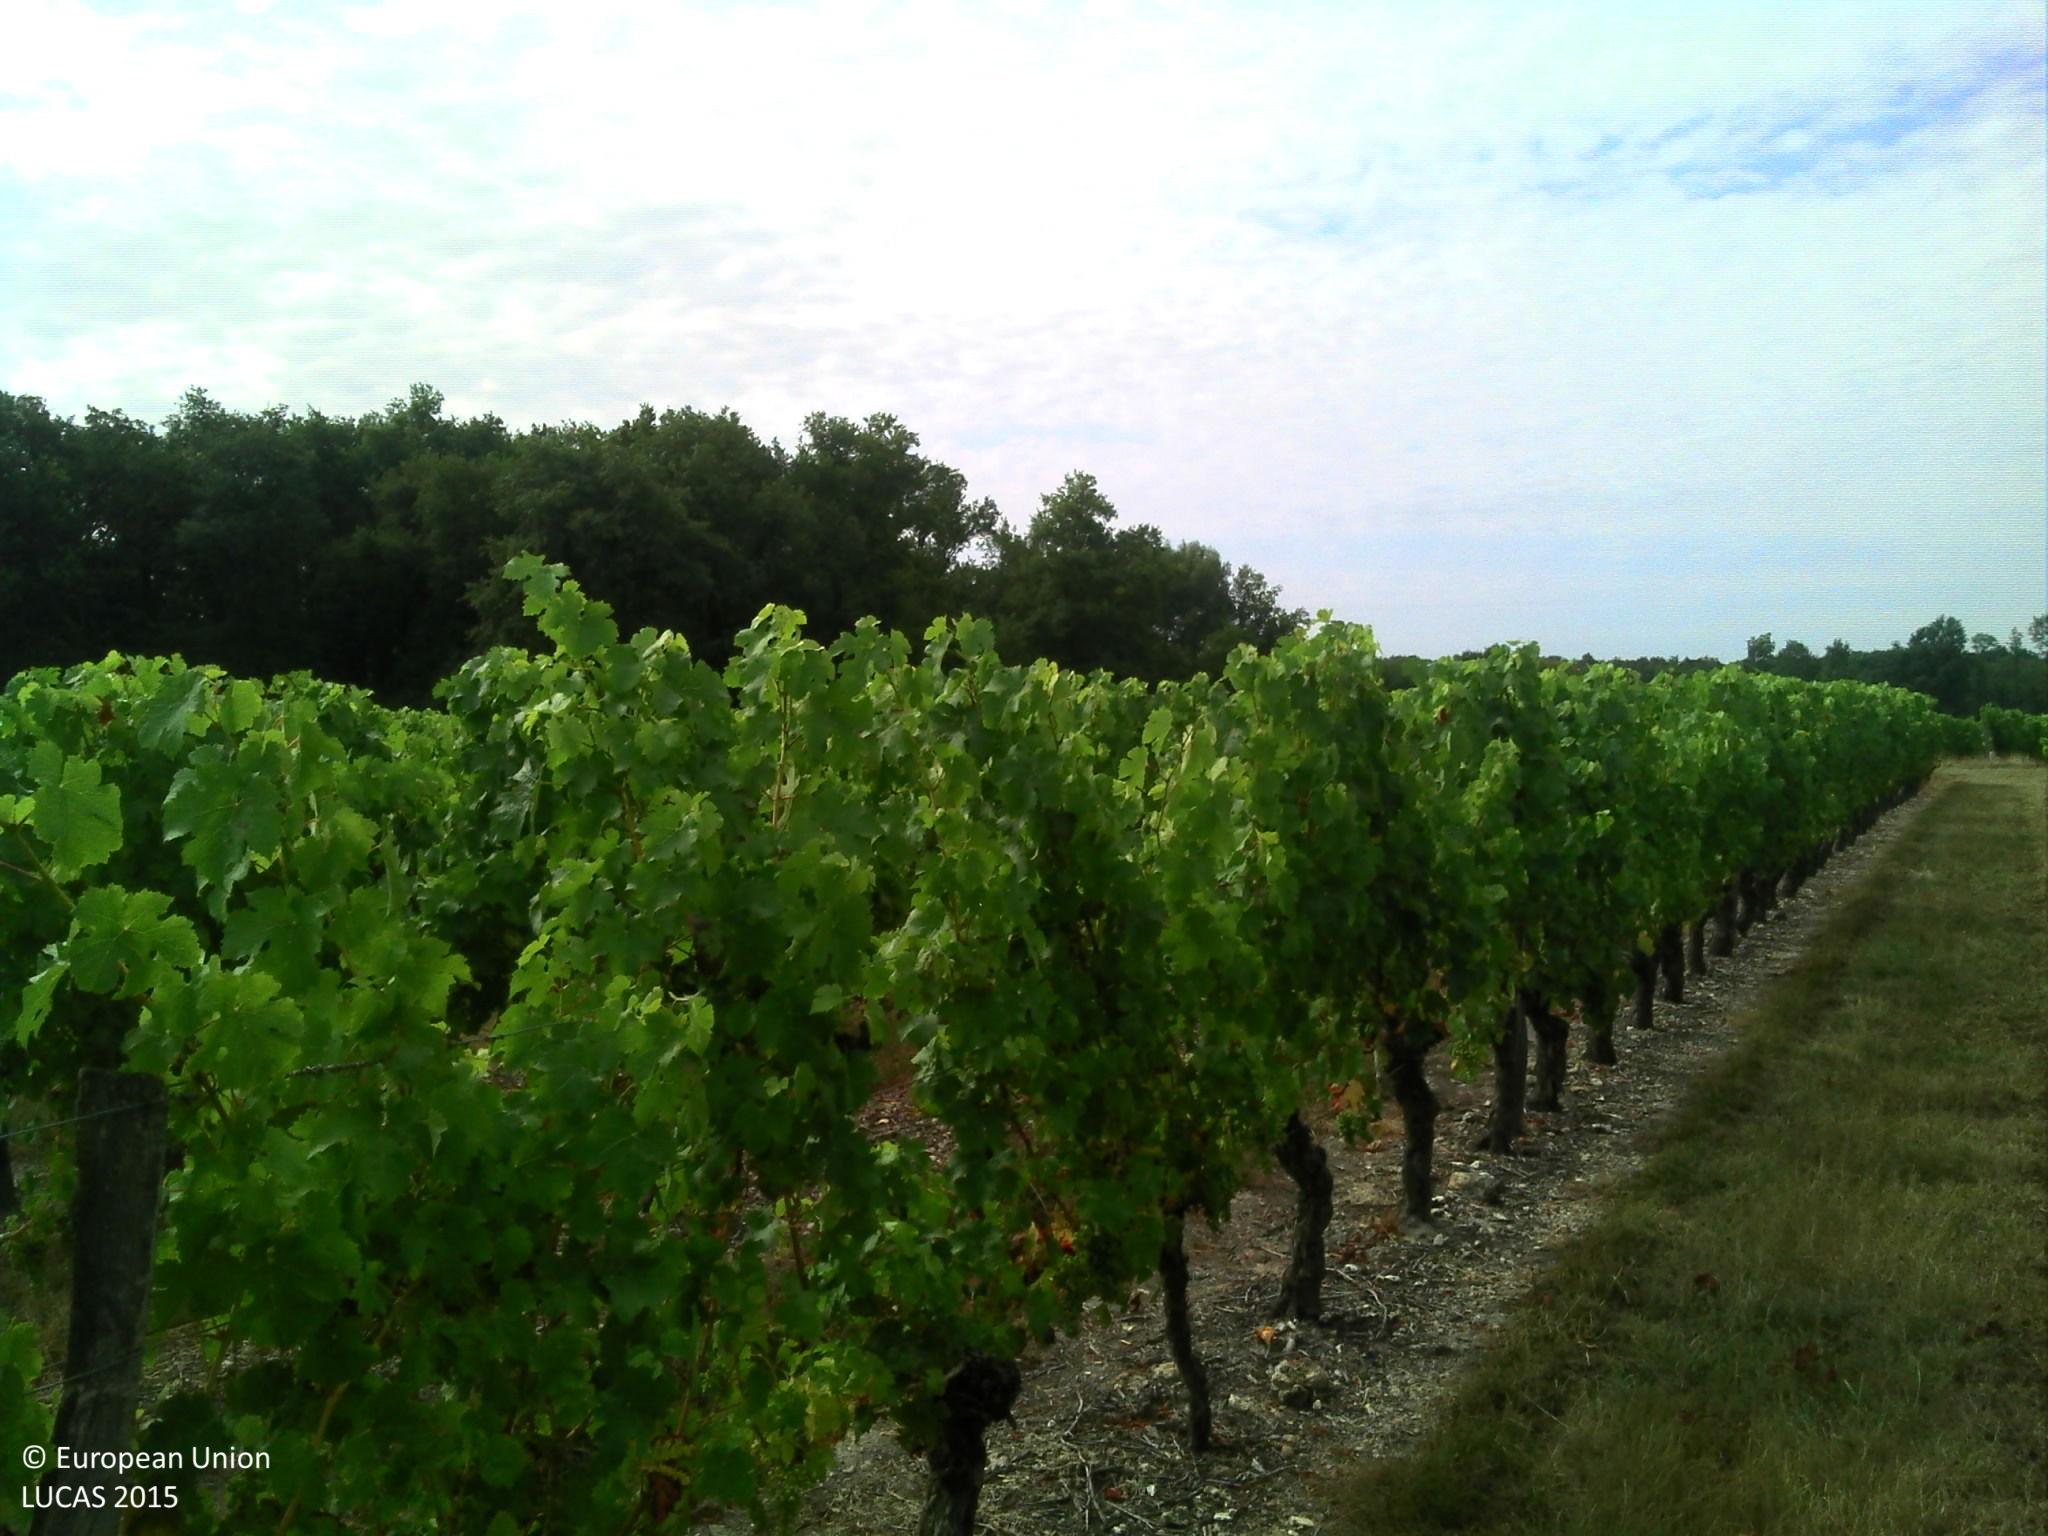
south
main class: Cropland
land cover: Vineyards
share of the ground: 50 - 75 %
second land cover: Grassland without tree/shrub cover
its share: 50 - 75 %
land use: Agriculture (excluding fallow land and kitchen gardens)
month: August
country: FR
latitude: 47.1660
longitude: 0.3617
